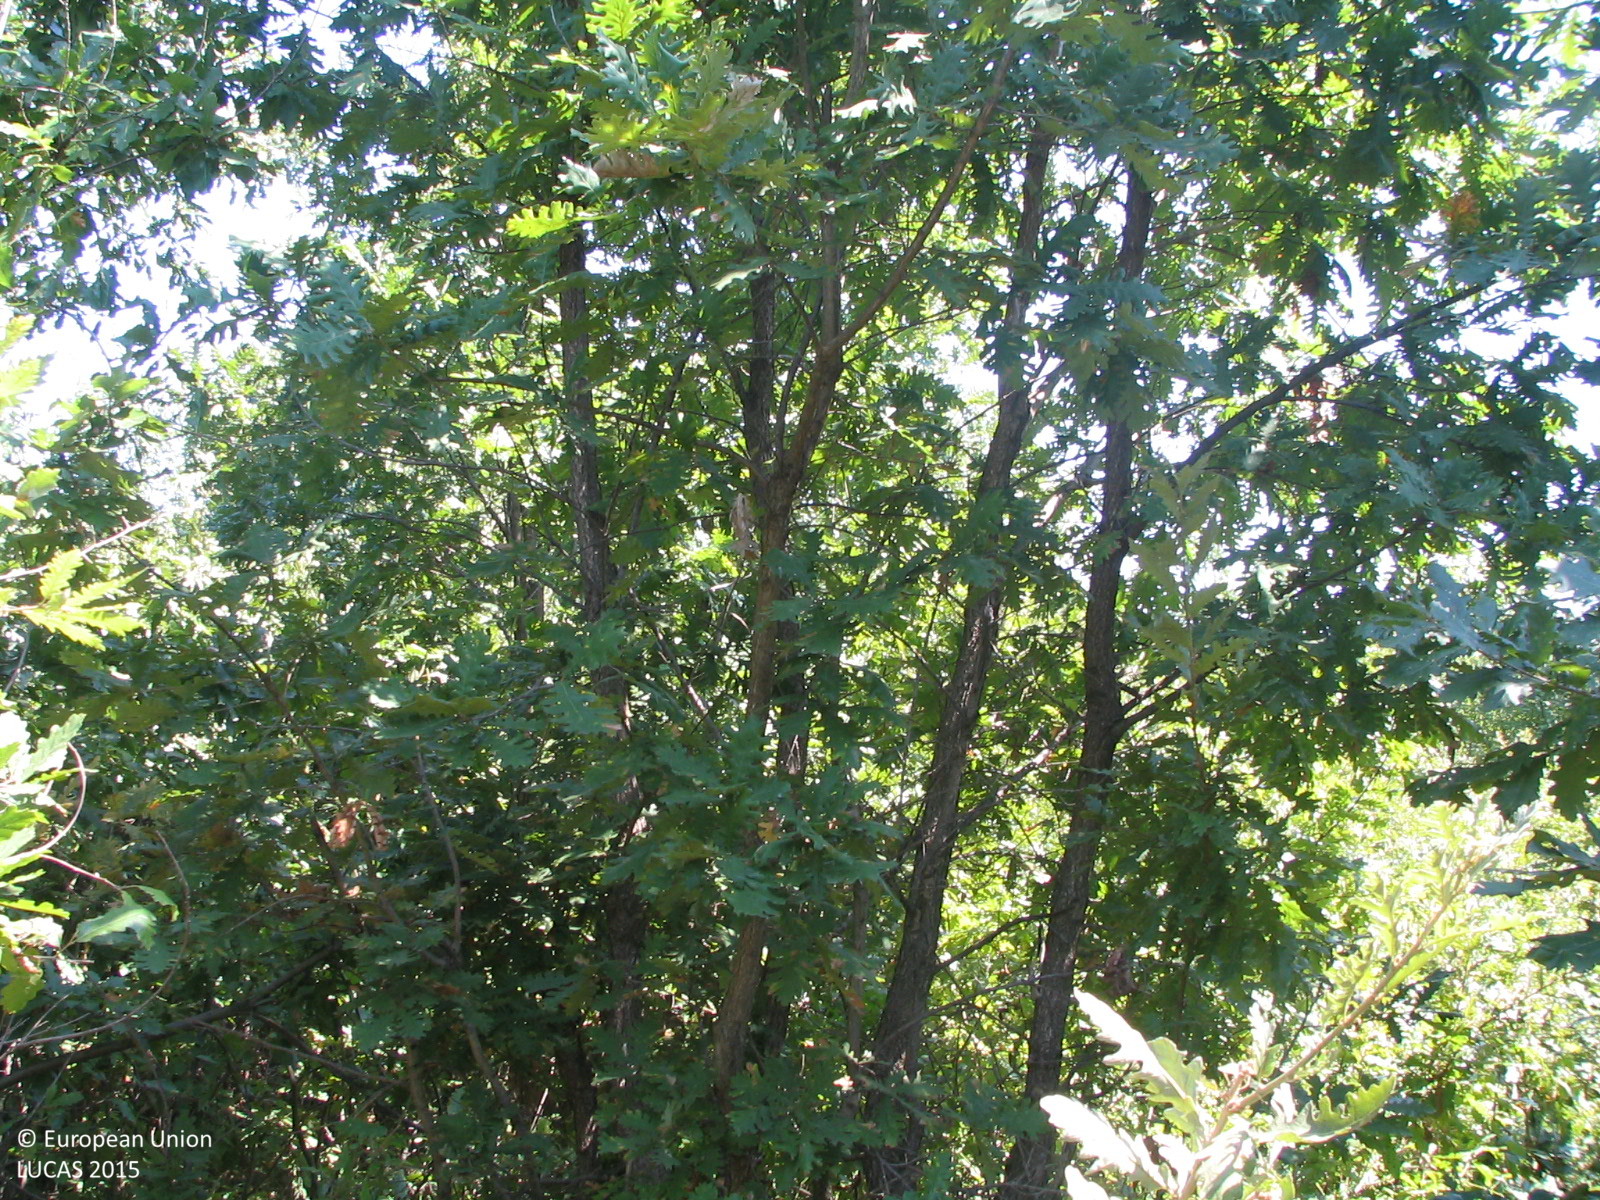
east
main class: Woodland
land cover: Broadleaved woodland
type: mesophytic deciduous forest
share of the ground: > 75 %
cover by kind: broadleaved forest trees 85 %, herbaceous plants 10 %, shrubs 5 %
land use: Forestry
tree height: > 5 m
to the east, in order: Broadleaved woodland; Rivers and streams; Broadleaved woodland
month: August
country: BG
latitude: 43.1770
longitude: 24.3882
